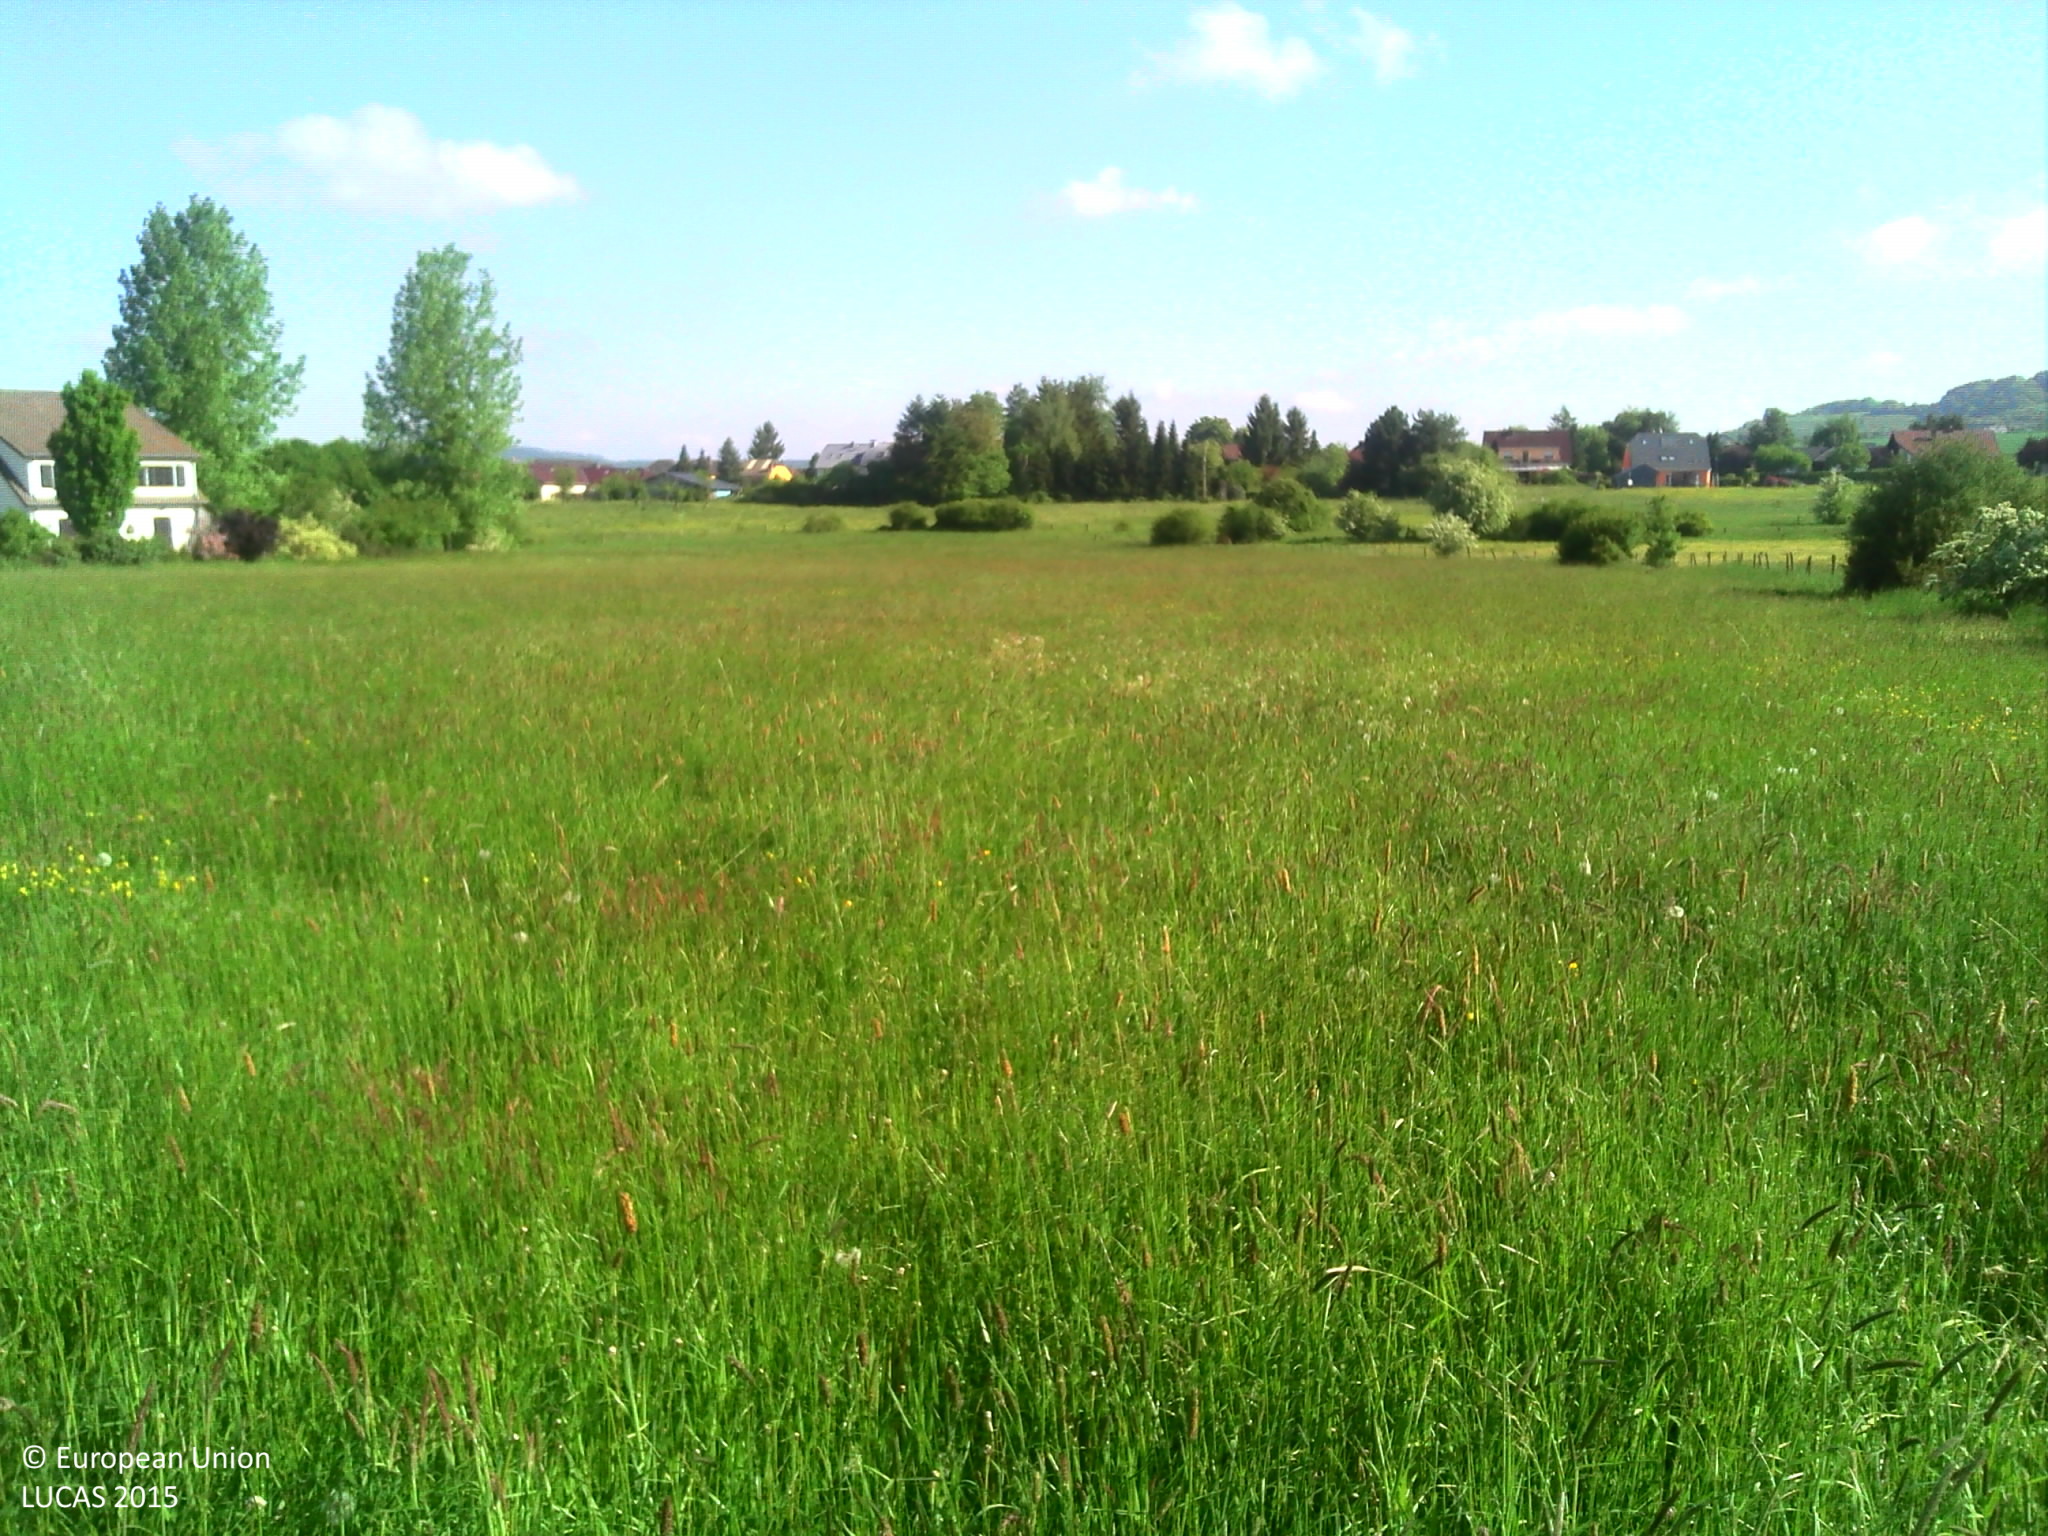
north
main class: Grassland
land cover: Grassland without tree/shrub cover
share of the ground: > 75 %
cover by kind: herbaceous plants 100 %
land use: Agriculture (excluding fallow land and kitchen gardens)
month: May
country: LU
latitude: 49.6194
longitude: 6.2761
